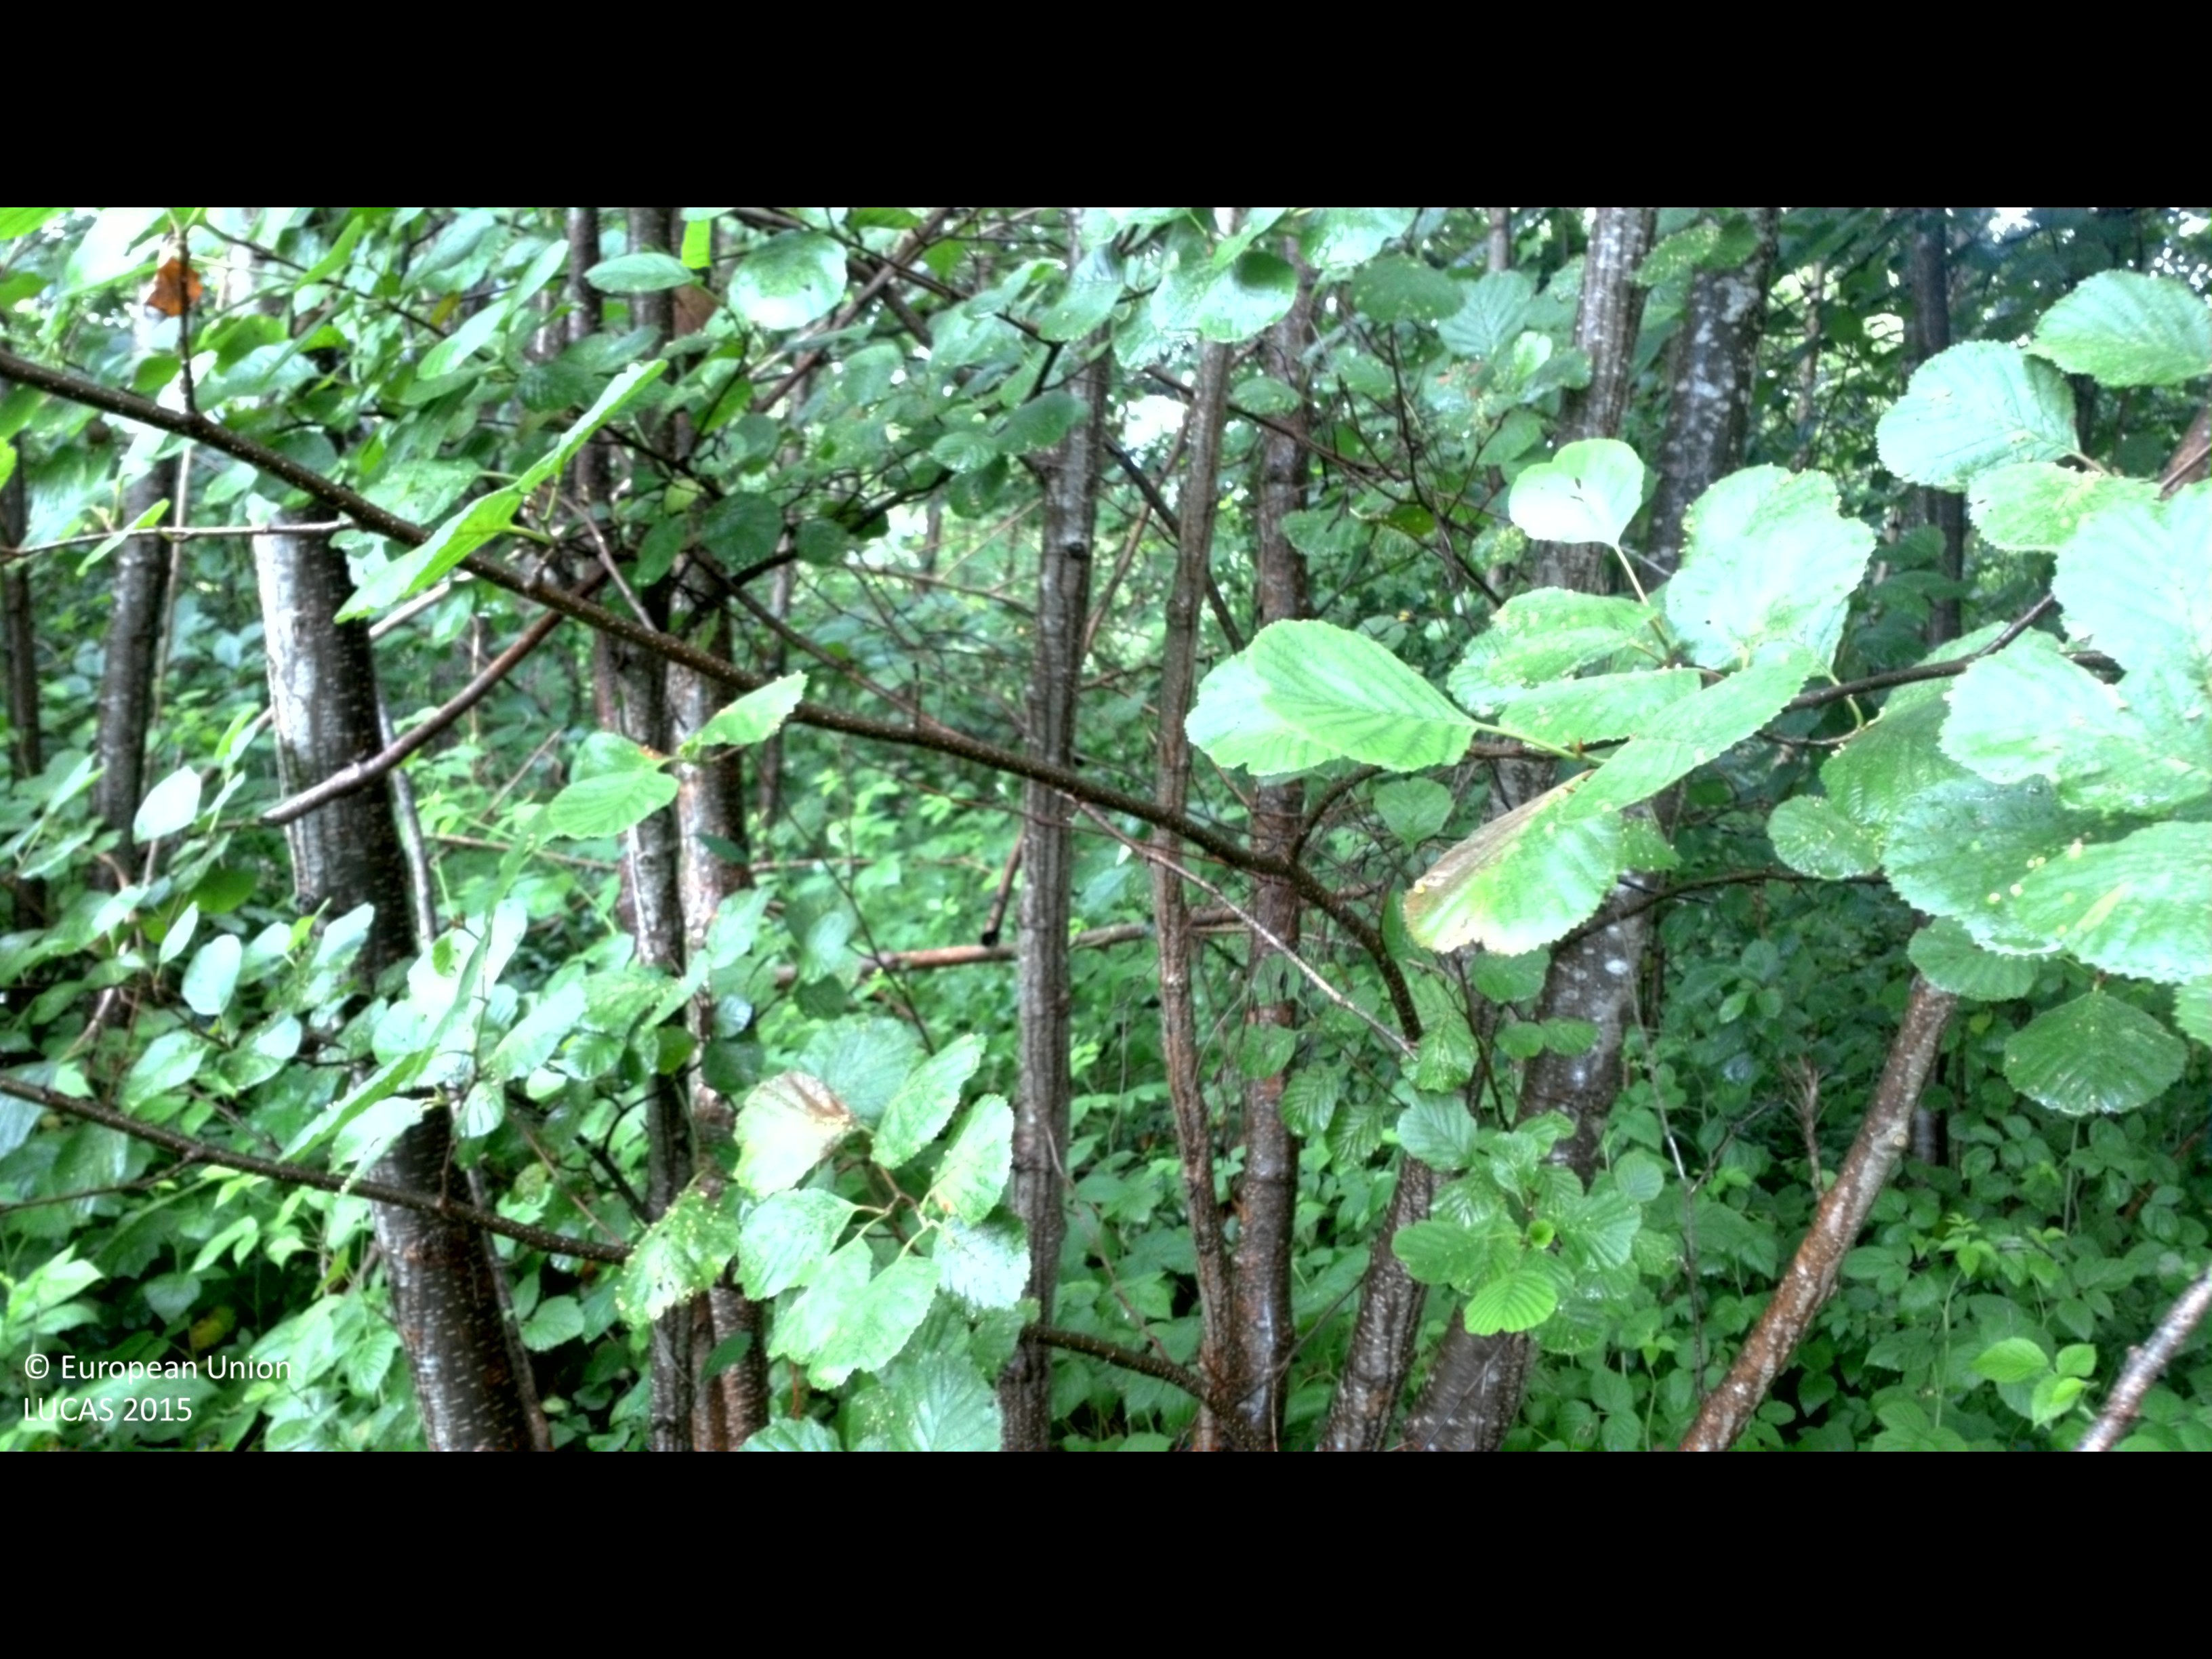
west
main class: Woodland
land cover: Broadleaved woodland
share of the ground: > 75 %
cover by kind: broadleaved forest trees 80 %, shrubs 20 %
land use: Amenities, museums, leisure
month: July
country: SE
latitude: 56.6378
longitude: 16.4743
